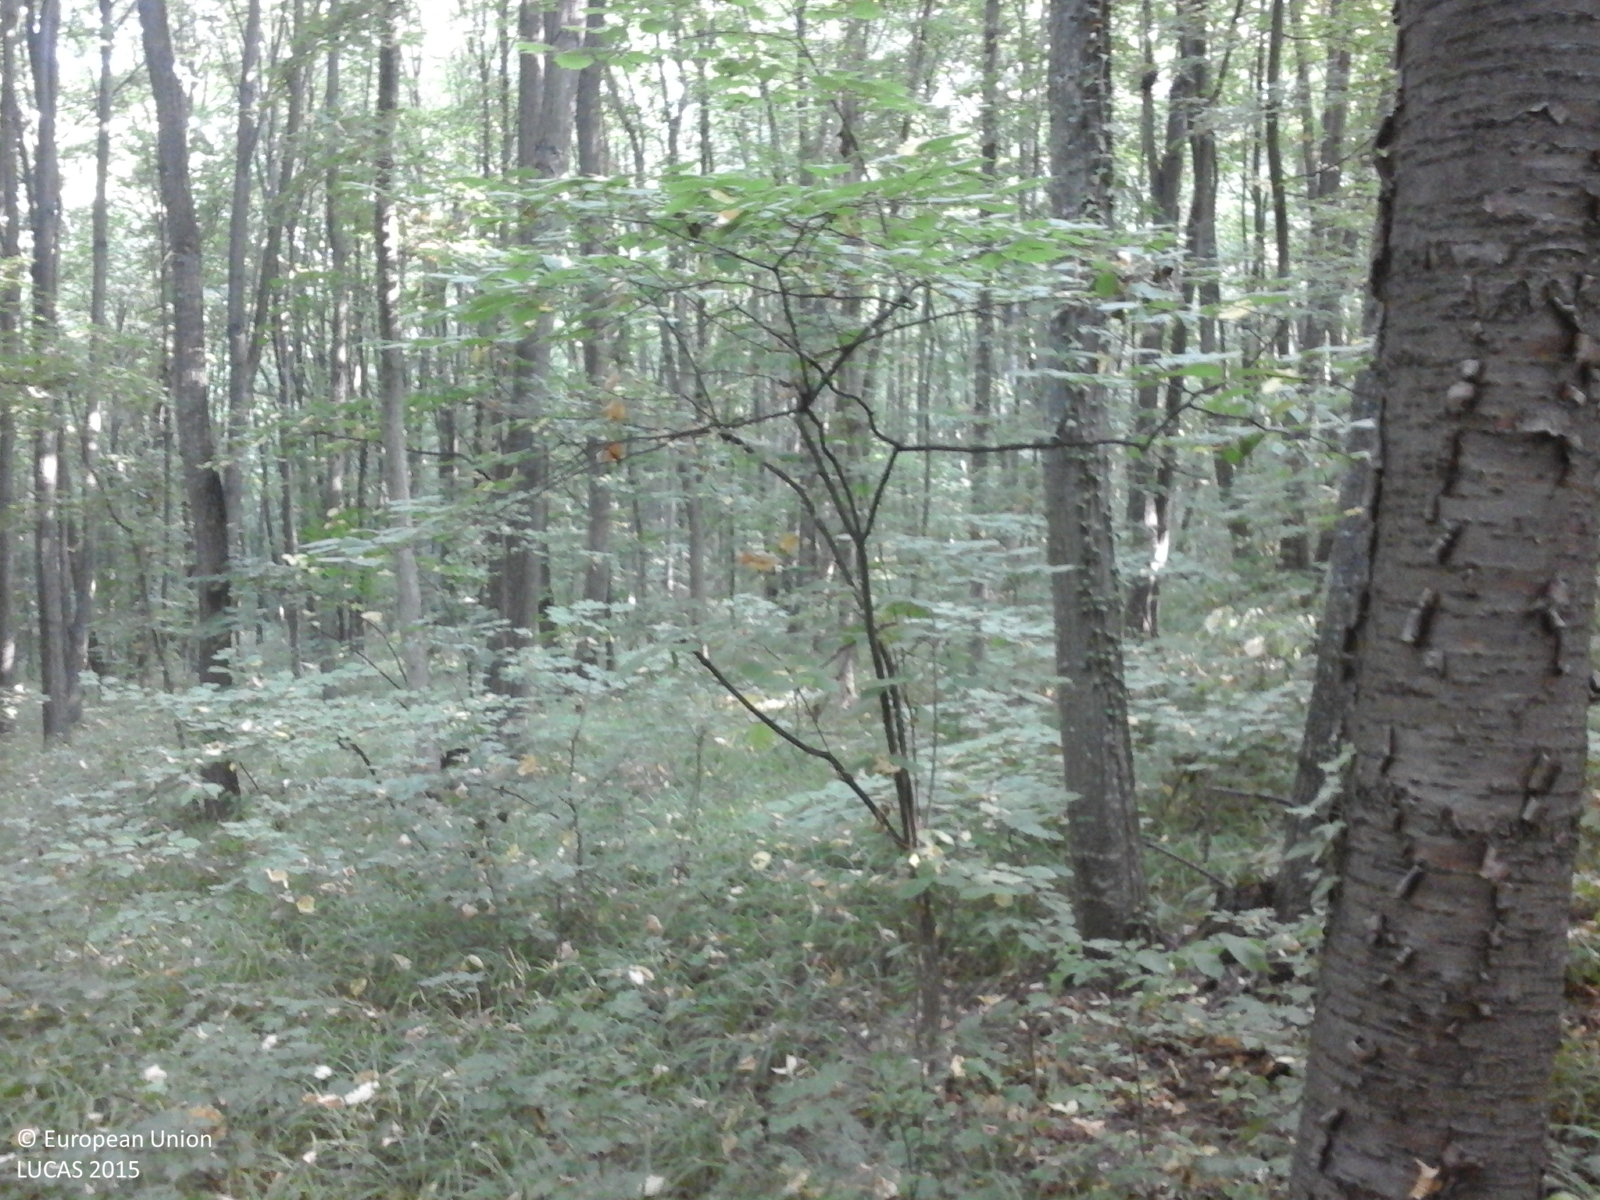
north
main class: Woodland
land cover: Broadleaved woodland
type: mesophytic deciduous forest
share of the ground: > 75 %
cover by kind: broadleaved forest trees 100 %
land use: Forestry
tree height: > 5 m
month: July
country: RO
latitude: 45.2124
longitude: 28.3206
